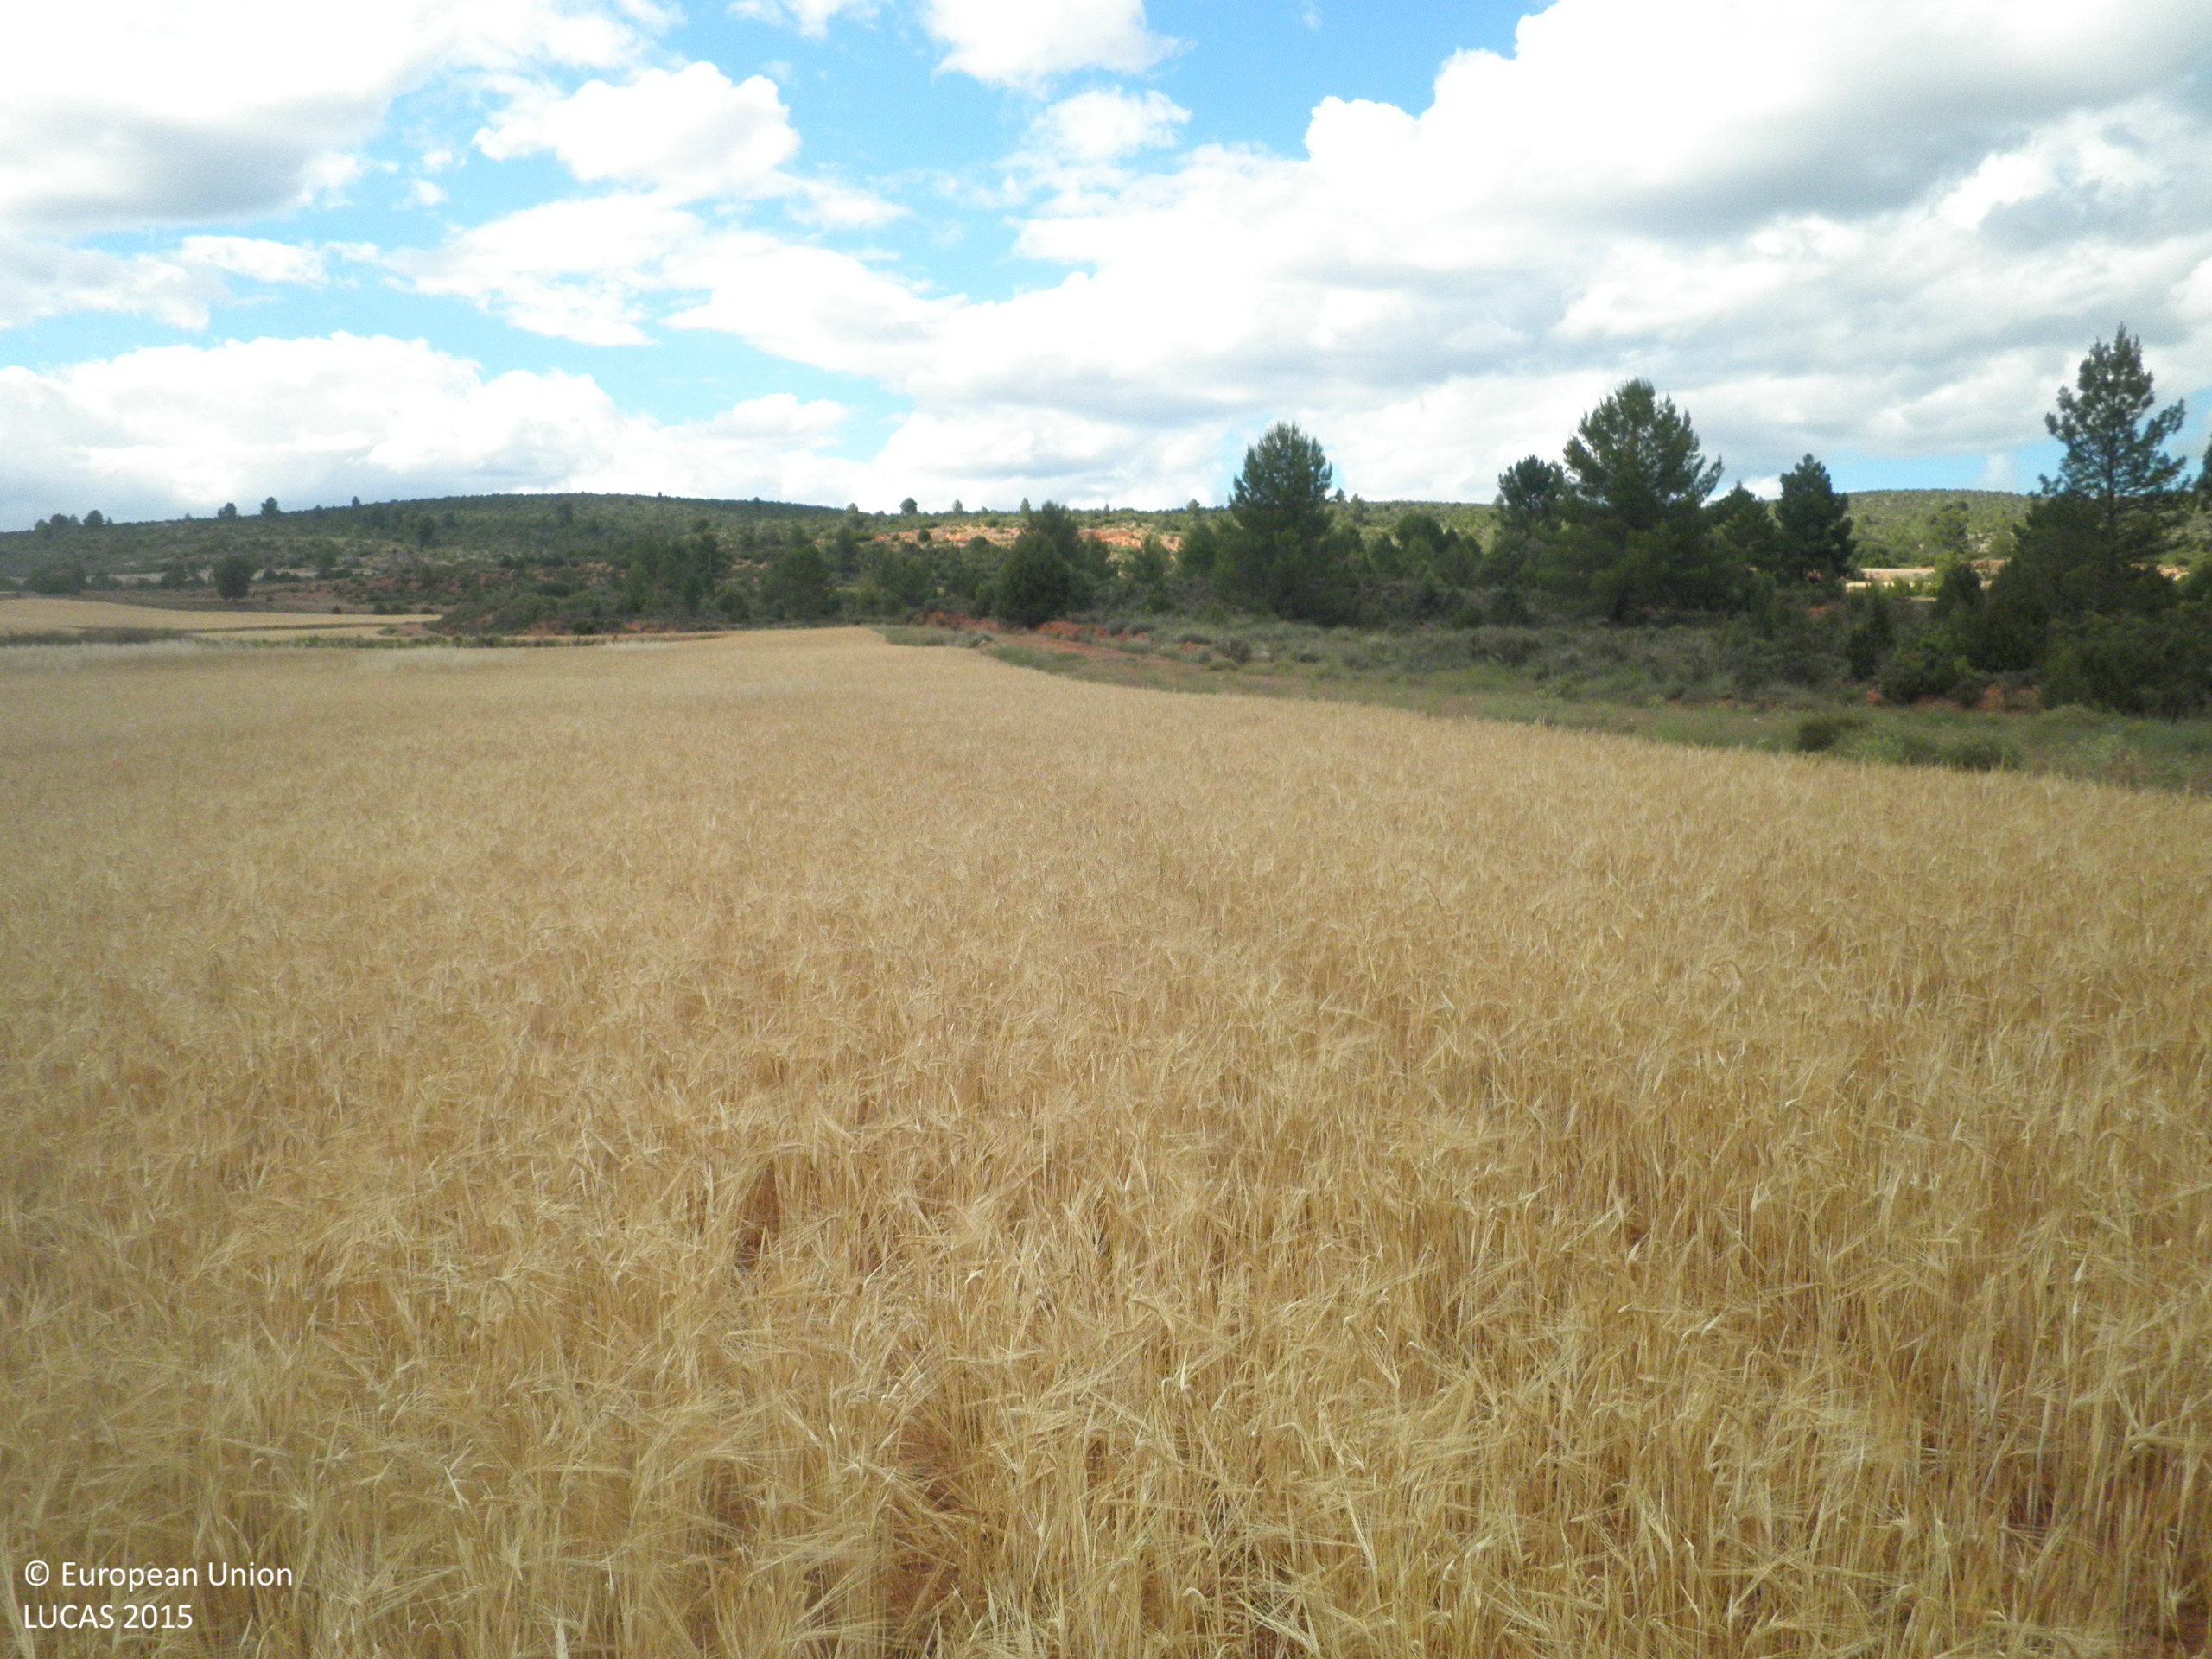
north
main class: Cropland
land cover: Barley
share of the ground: > 75 %
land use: Agriculture (excluding fallow land and kitchen gardens)
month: June
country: ES
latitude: 39.7485
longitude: -1.6906
